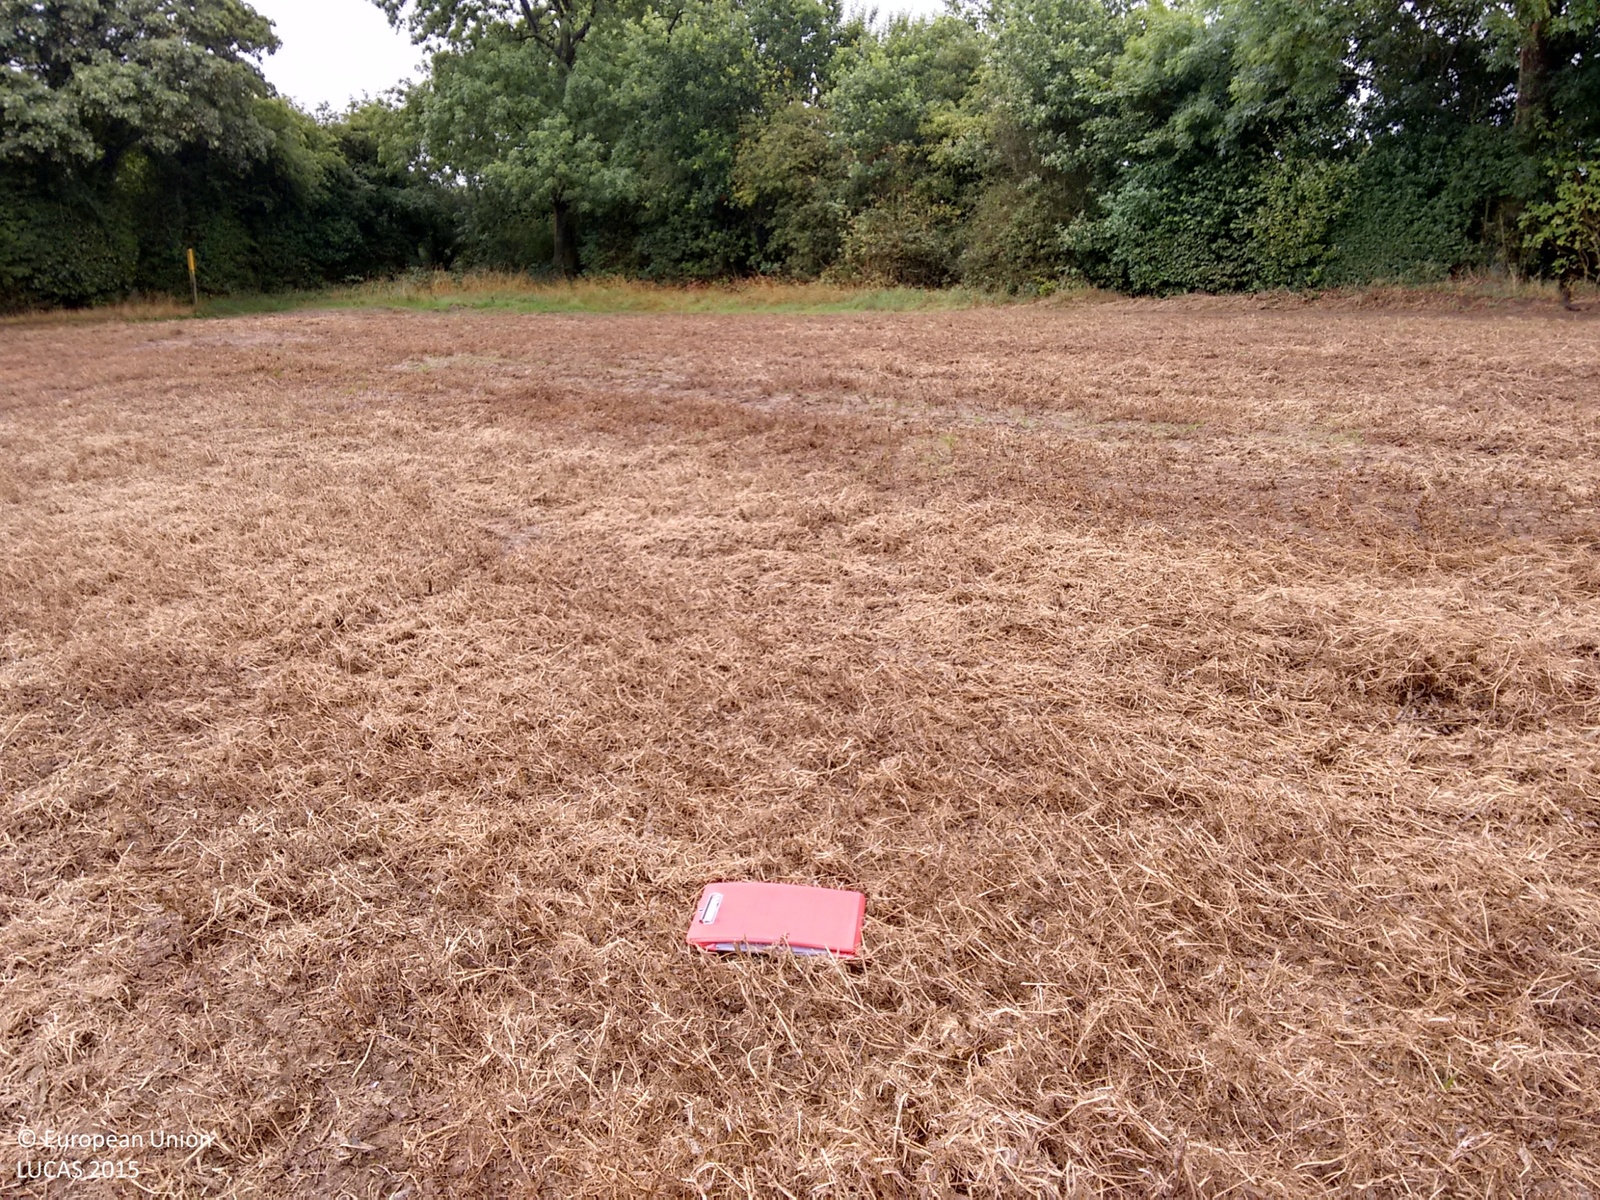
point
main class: Cropland
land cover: Dry pulses
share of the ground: > 75 %
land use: Agriculture (excluding fallow land and kitchen gardens)
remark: Harvested field
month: September
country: GB
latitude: 52.7662
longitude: -1.4470
